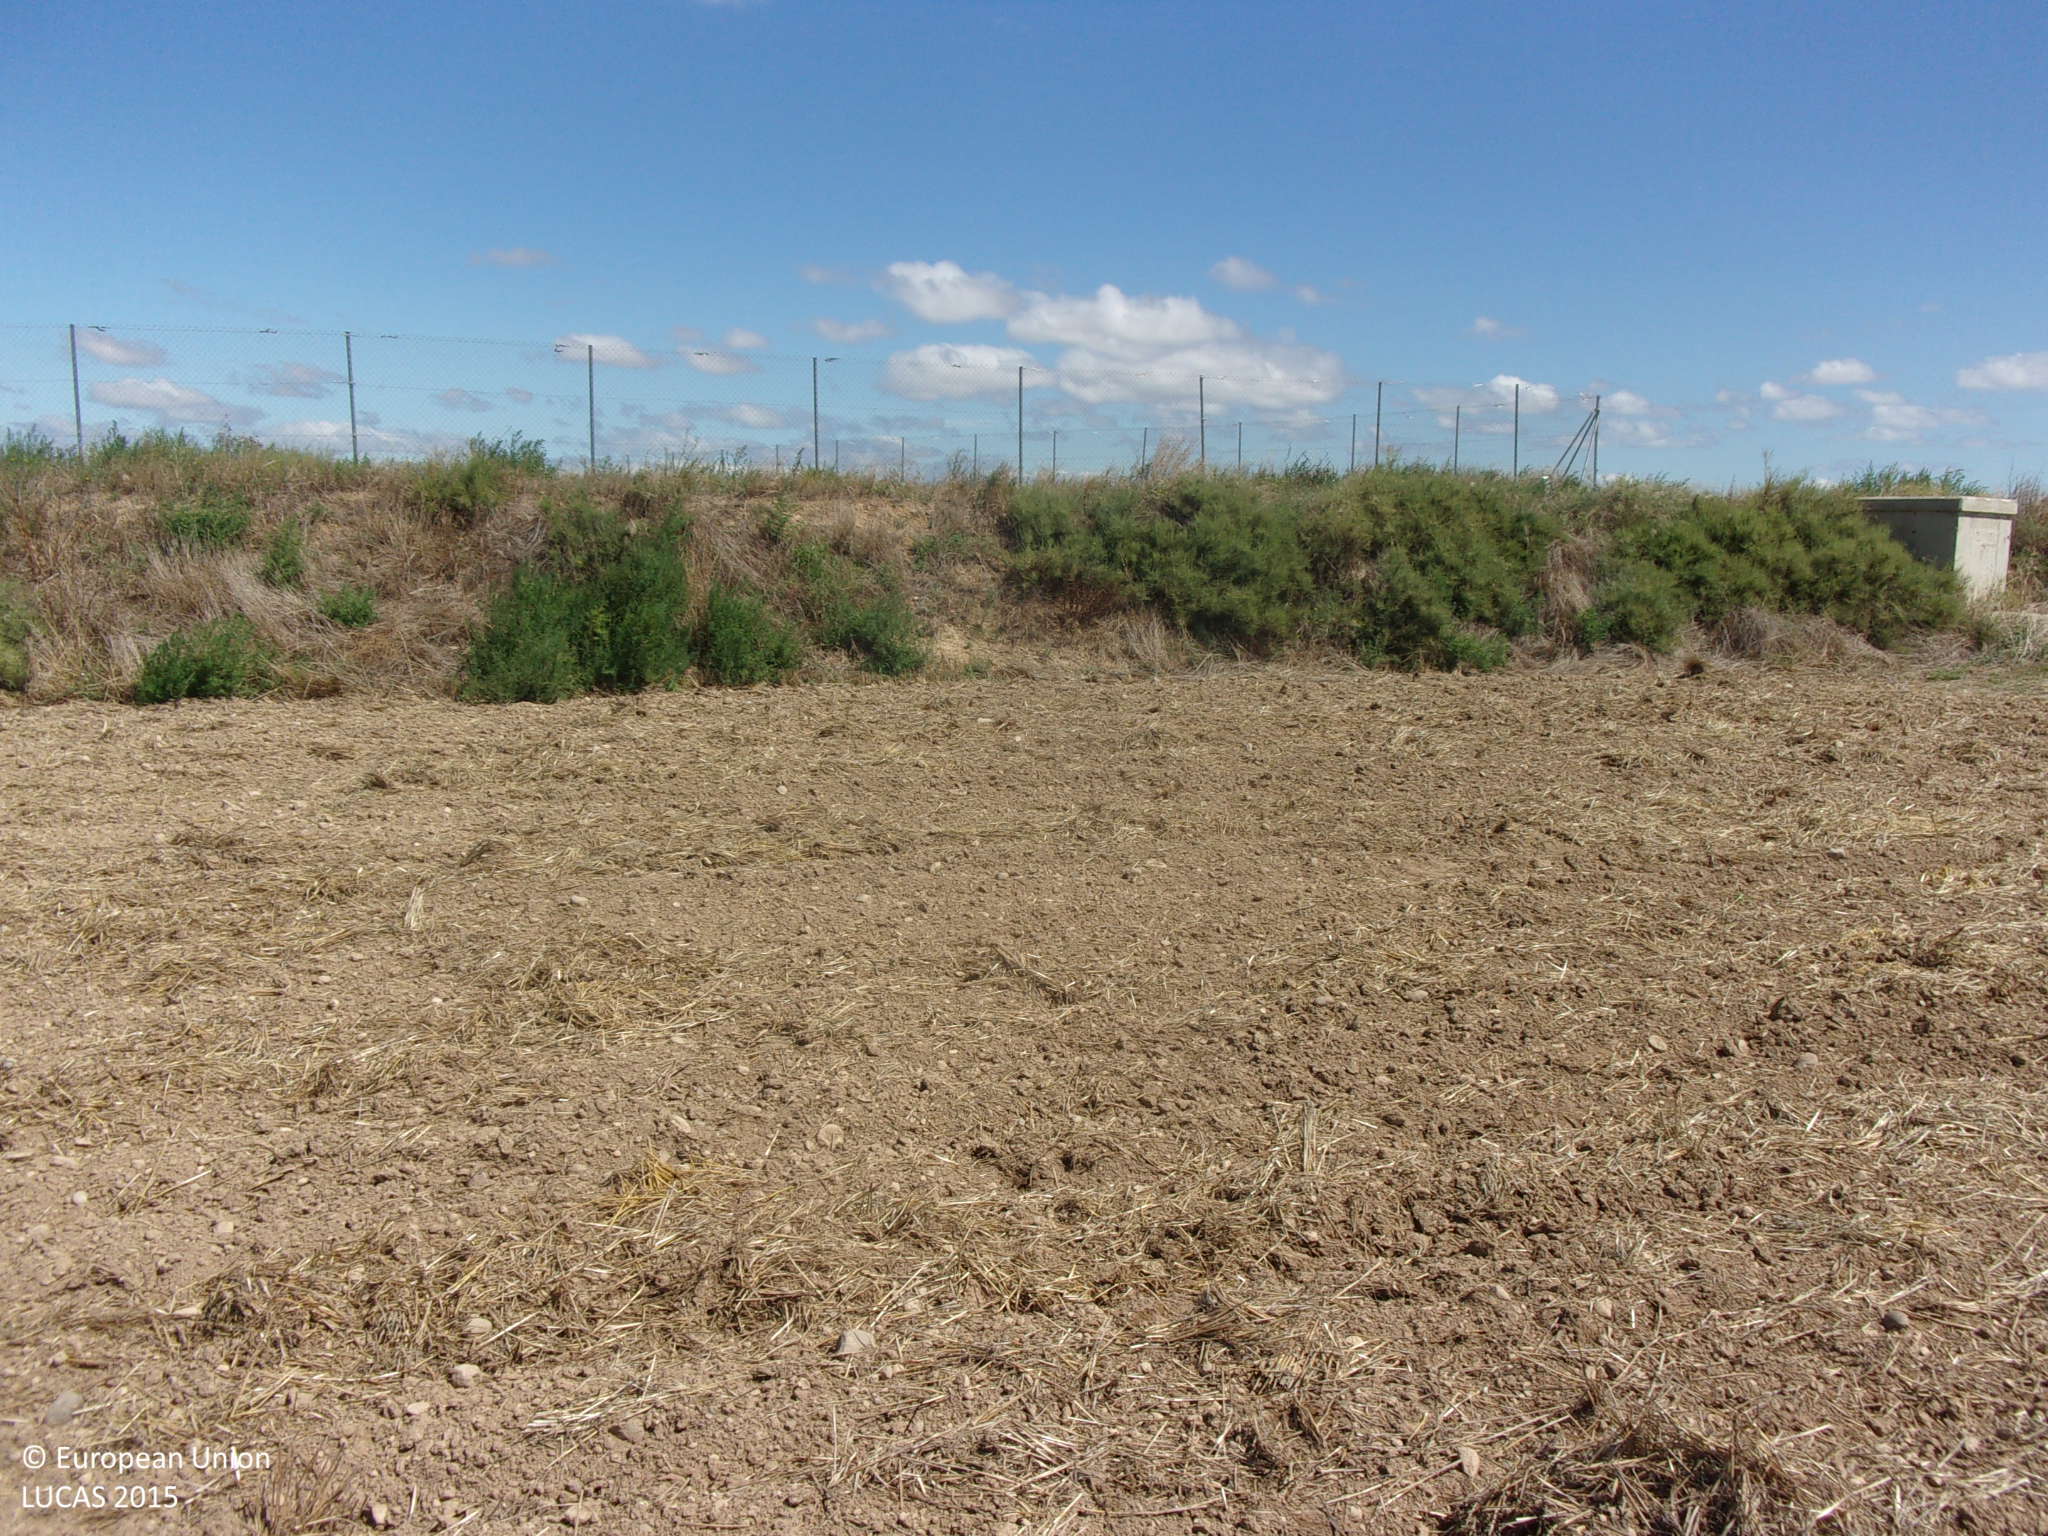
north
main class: Cropland
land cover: Barley
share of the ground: < 10 %
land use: Agriculture (excluding fallow land and kitchen gardens)
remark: Harvested field
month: August
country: ES
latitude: 42.1307
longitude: -1.1215
